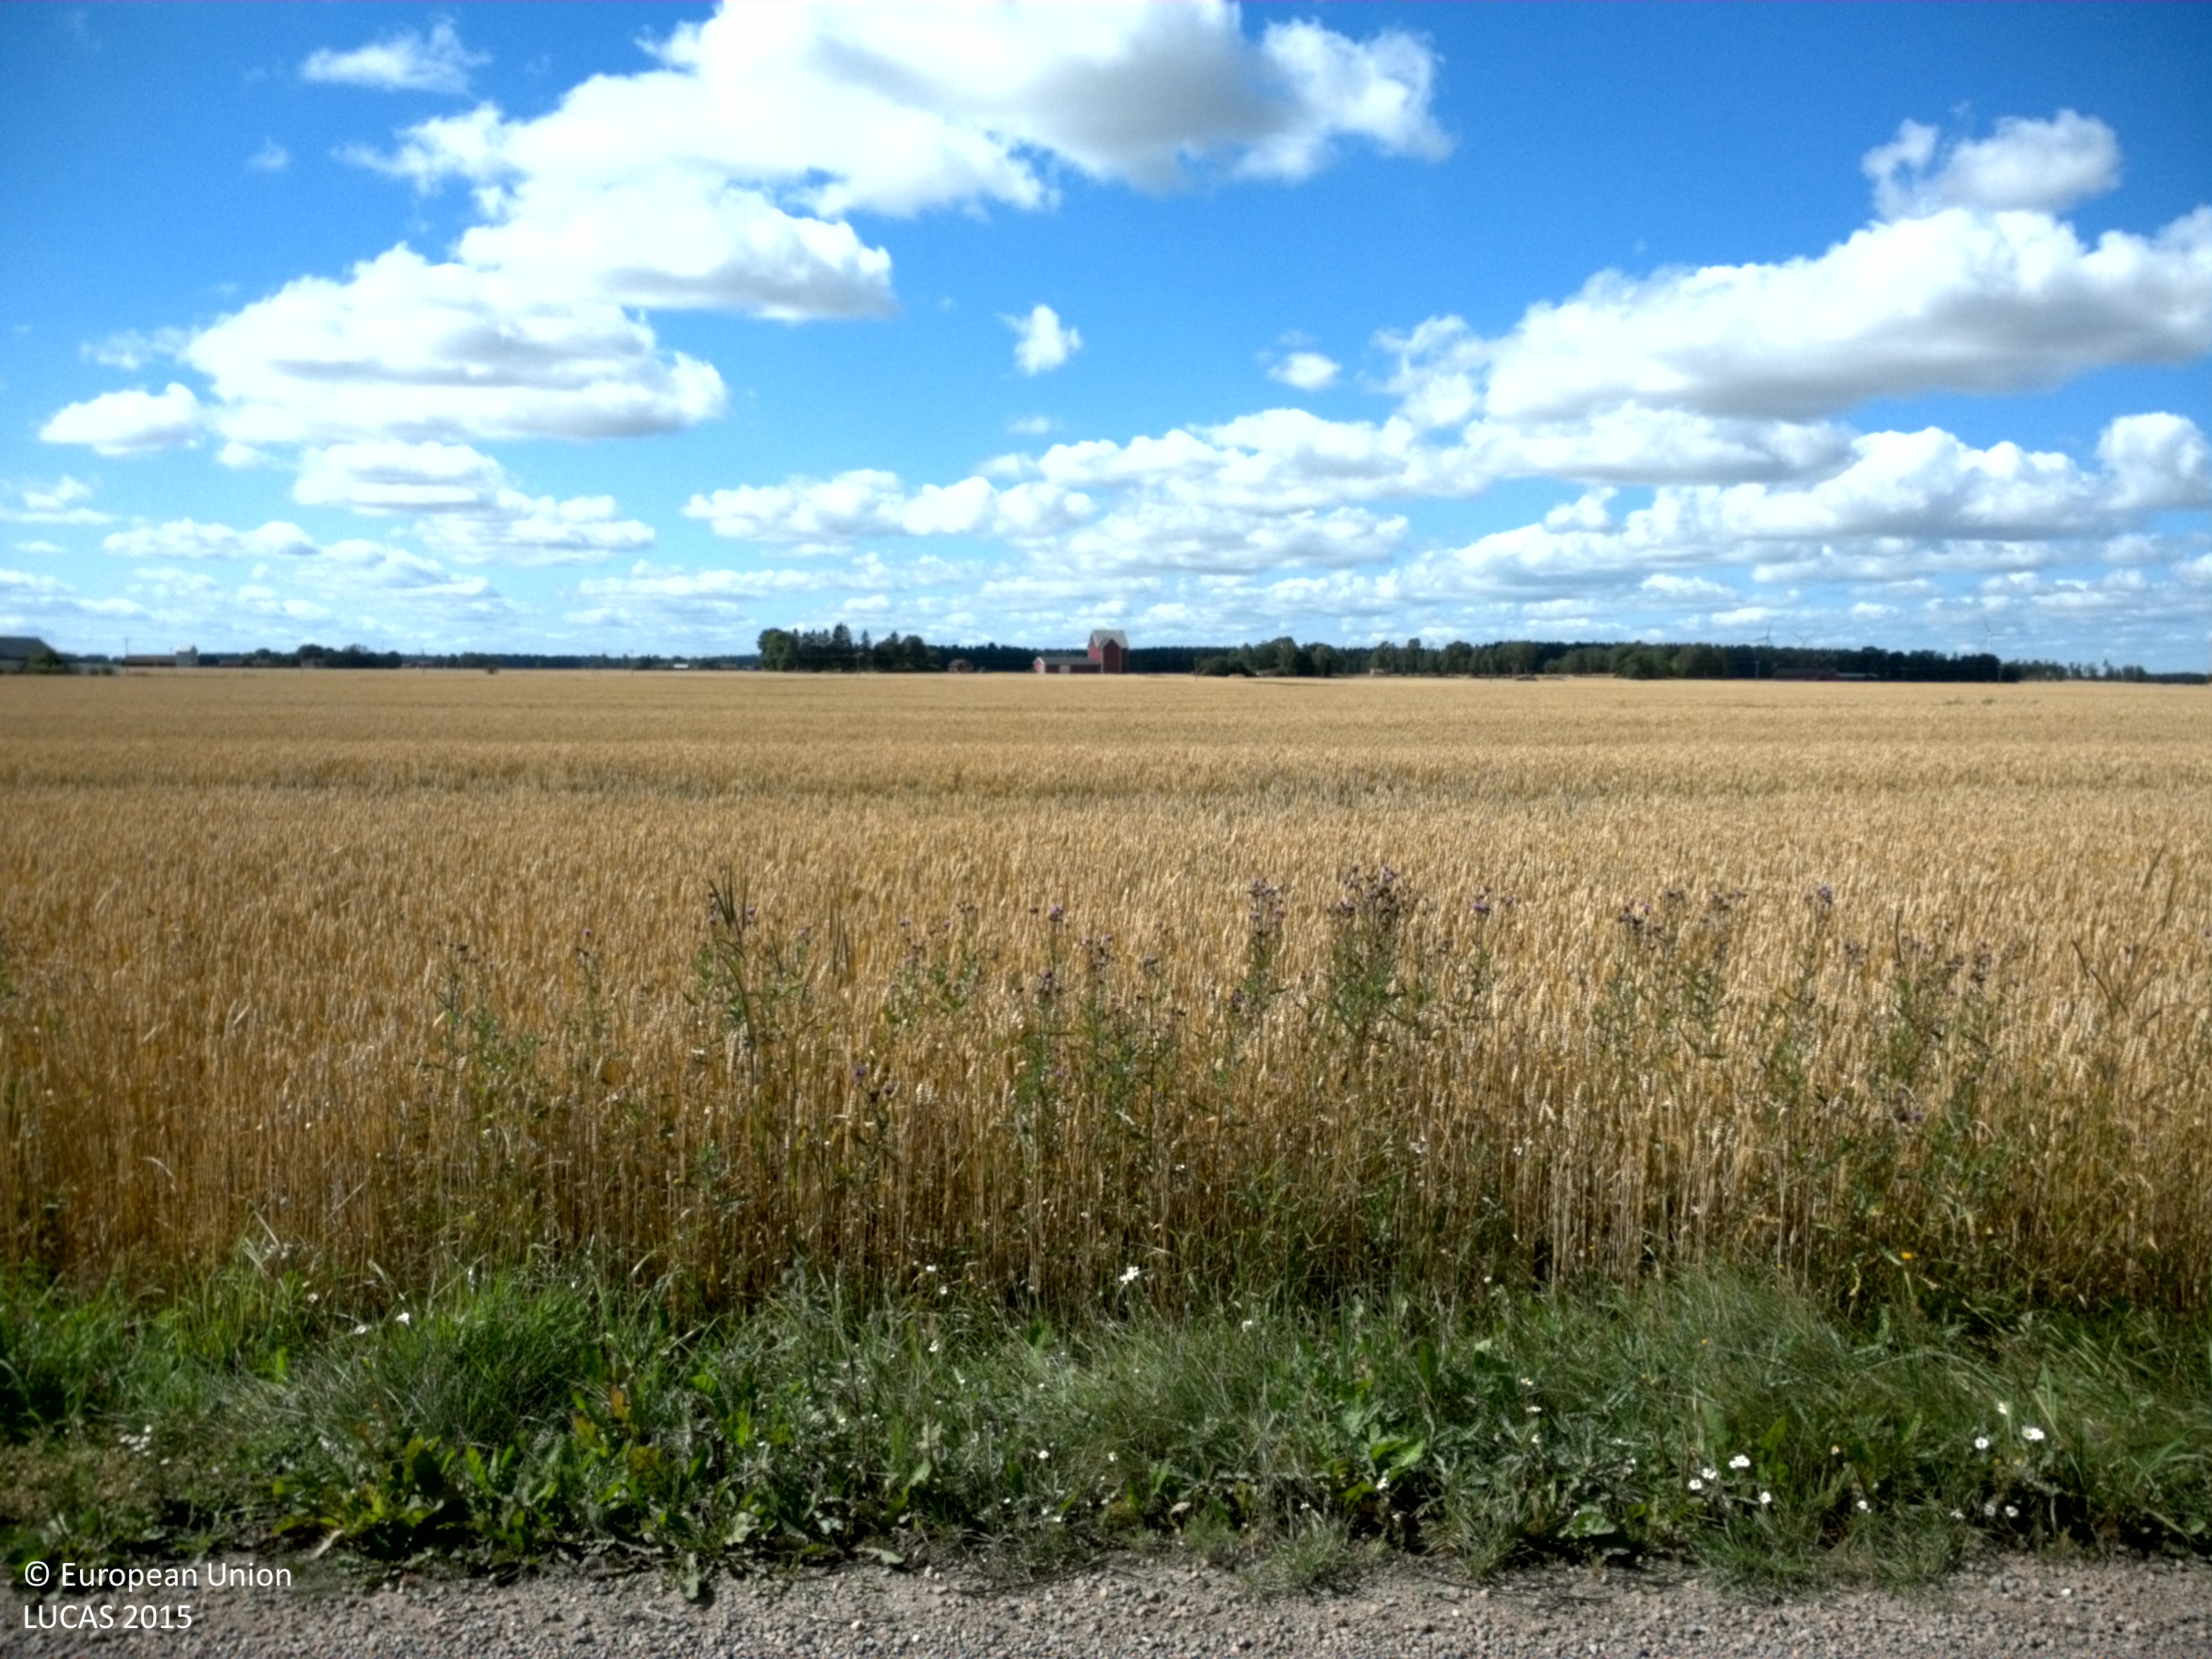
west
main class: Cropland
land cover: Common wheat
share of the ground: > 75 %
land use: Agriculture (excluding fallow land and kitchen gardens)
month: August
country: SE
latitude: 58.2711
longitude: 13.2166
